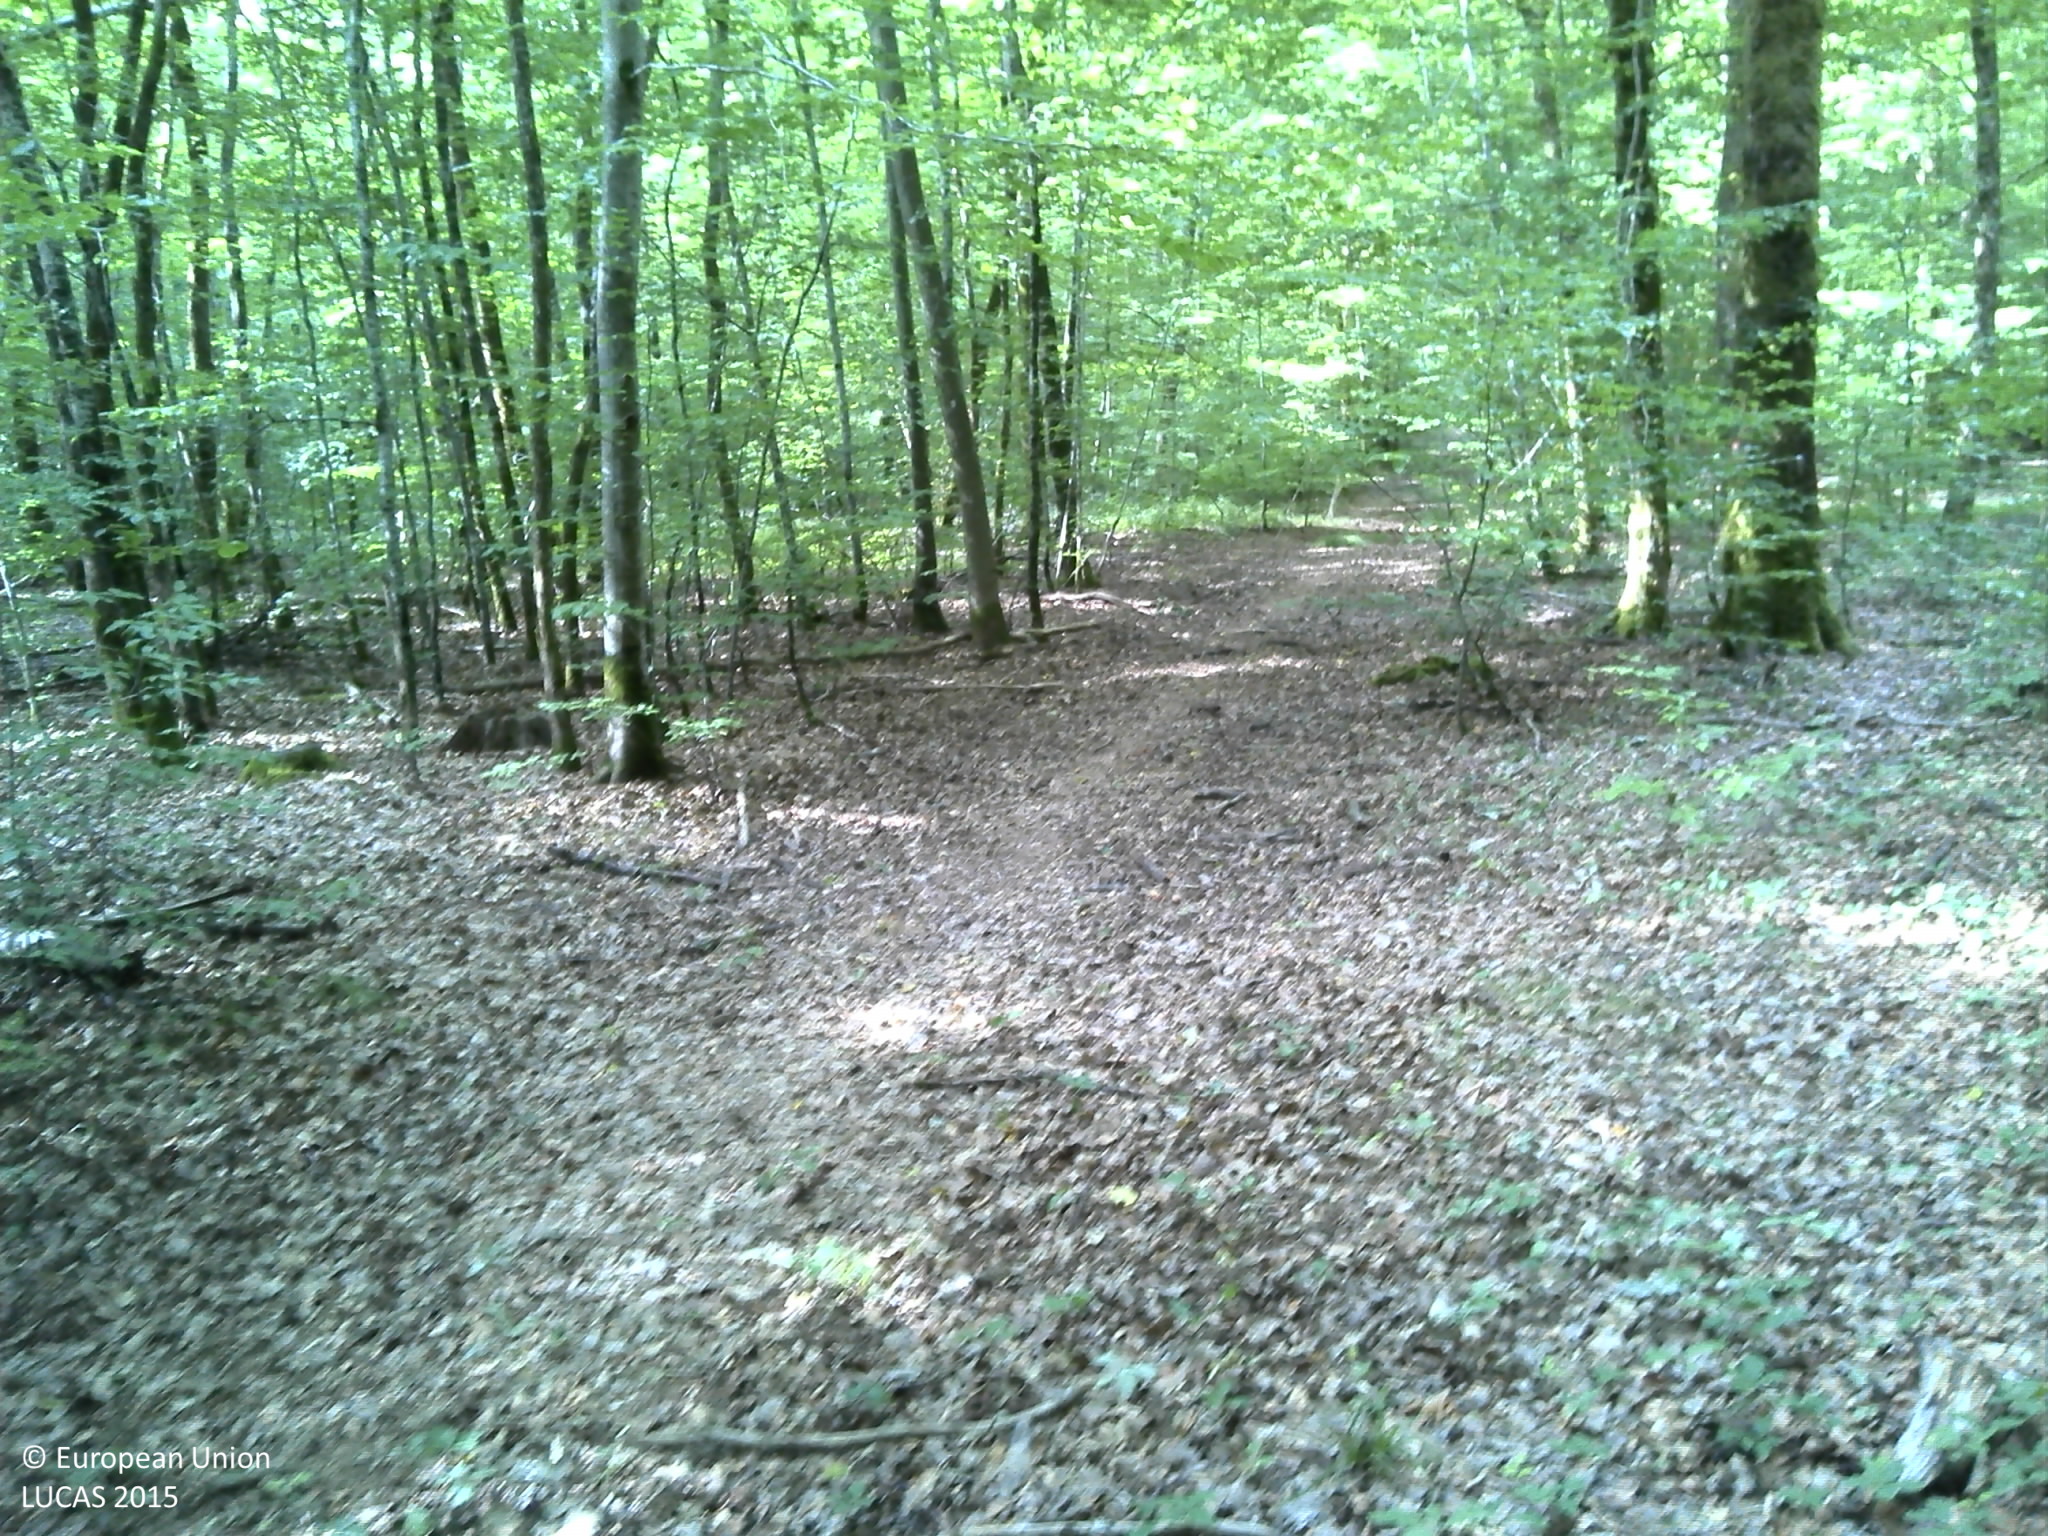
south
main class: Woodland
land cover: Broadleaved woodland
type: acidophilous oak and oak-birch forest
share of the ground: > 75 %
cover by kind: broadleaved forest trees 90 %, herbaceous plants 5 %, unconsolidated bare surface 5 %
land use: Forestry
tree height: > 5 m
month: July
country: FR
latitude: 48.0076
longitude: 6.0194
